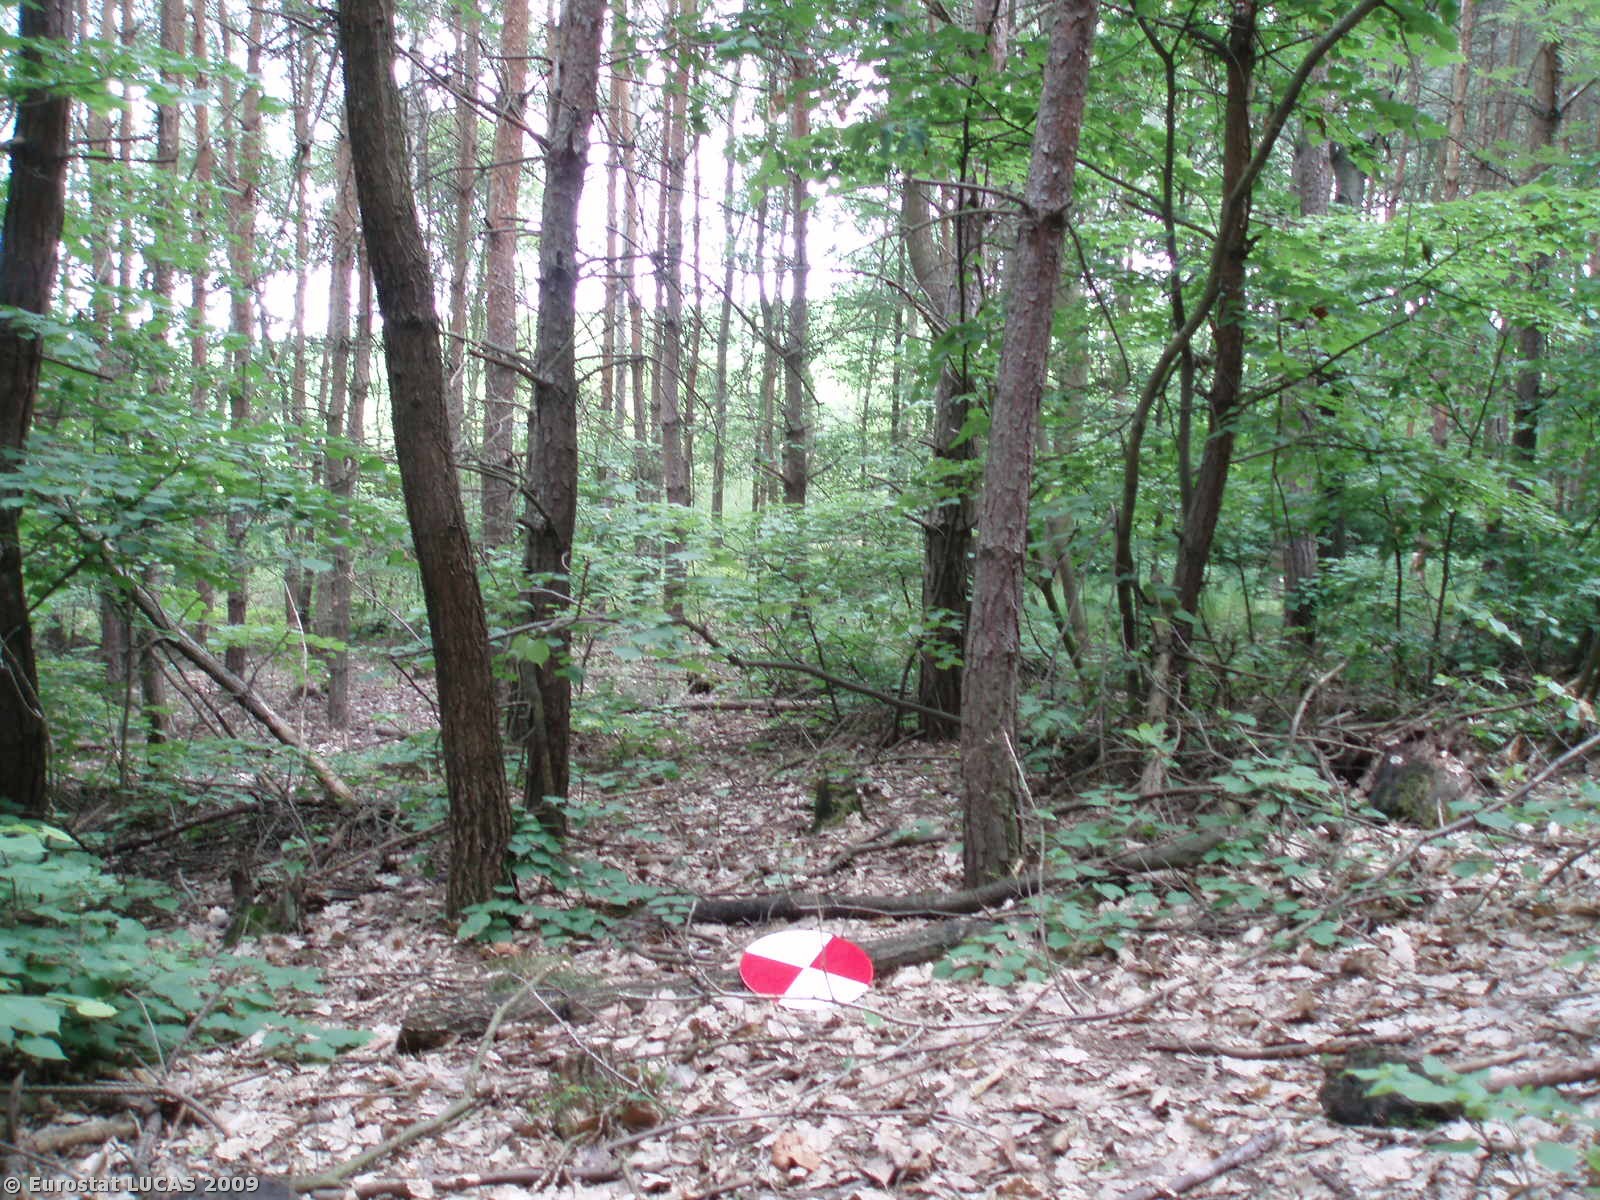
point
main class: Woodland
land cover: Mixed woodland
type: hemiboreal forest and nemoral coniferous forest and mixed broadleaved-coniferous forest
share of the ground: > 75 %
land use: Forestry
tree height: > 5 m
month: May
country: CZ
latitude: 50.2601
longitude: 13.9425
